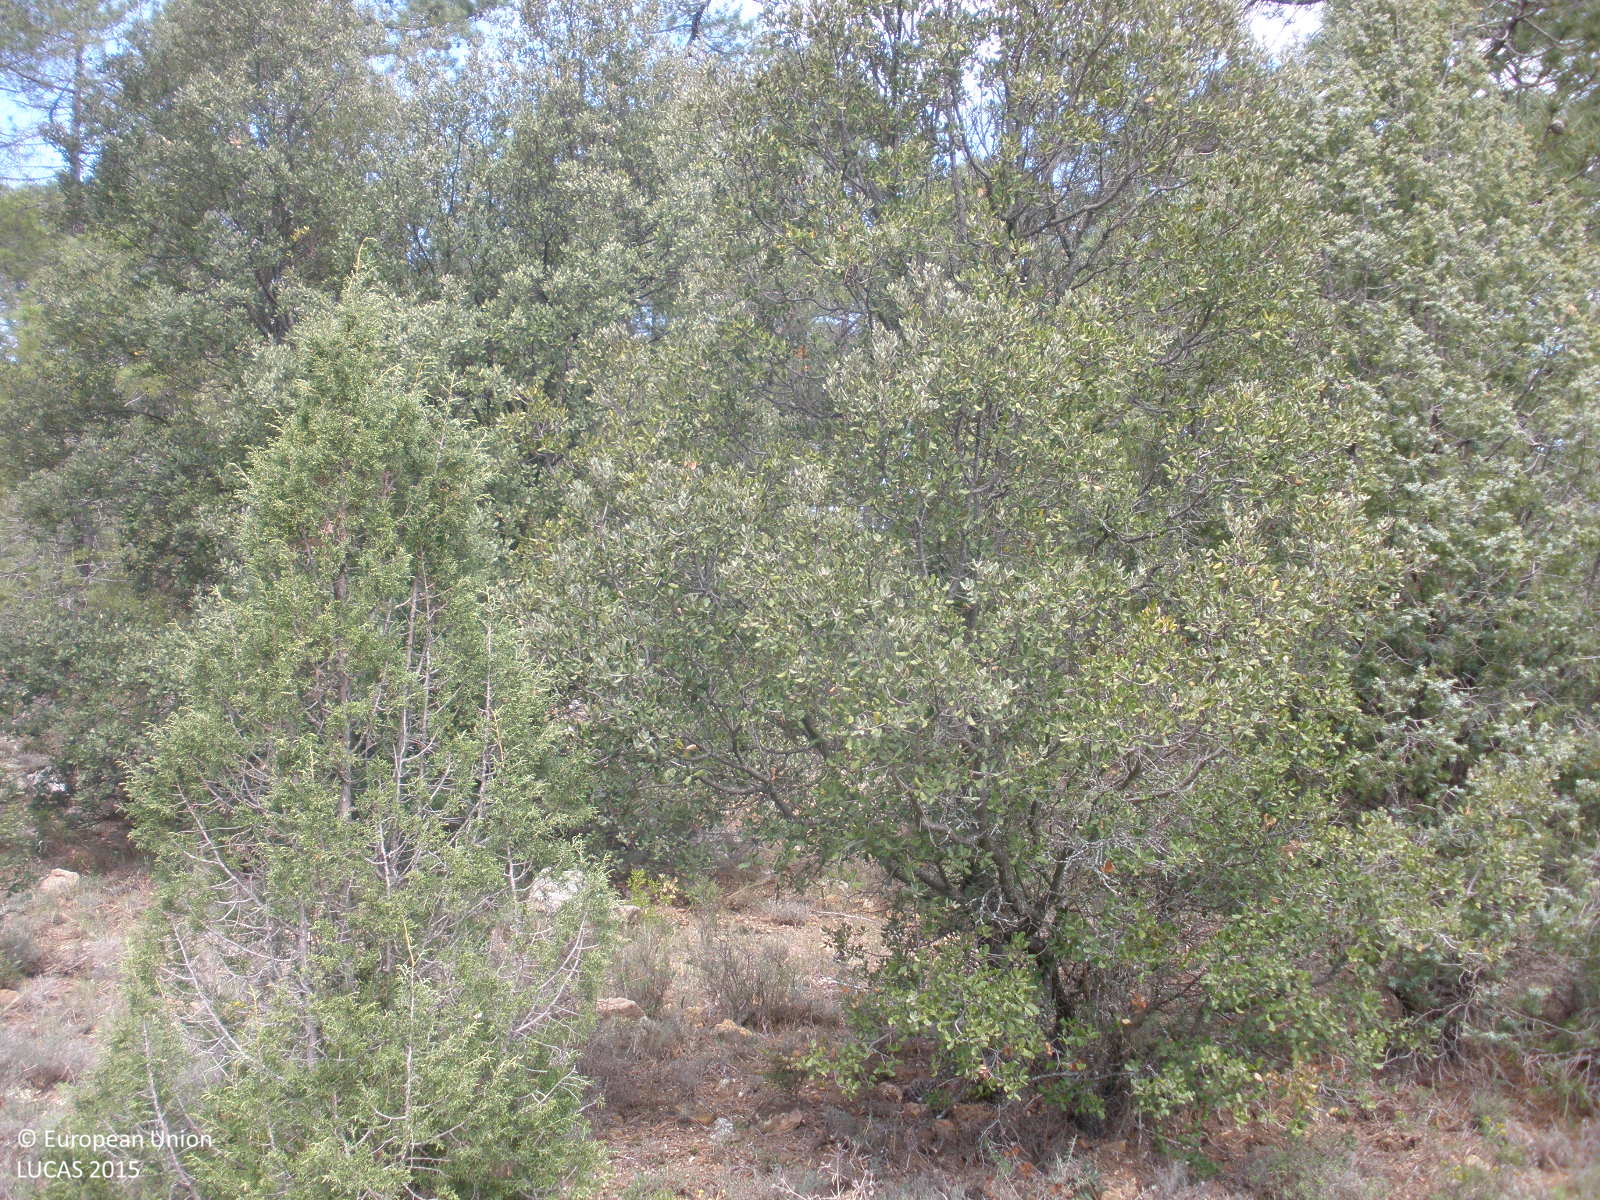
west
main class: Woodland
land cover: Other coniferous woodland
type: coniferous forest of the mediterranean region
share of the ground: 50 - 75 %
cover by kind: coniferous forest trees 50 %, shrubs 30 %, herbaceous plants 10 %, unconsolidated bare surface 10 %
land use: Forestry
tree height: < 5 m
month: April
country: ES
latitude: 40.2695
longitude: -0.8150
